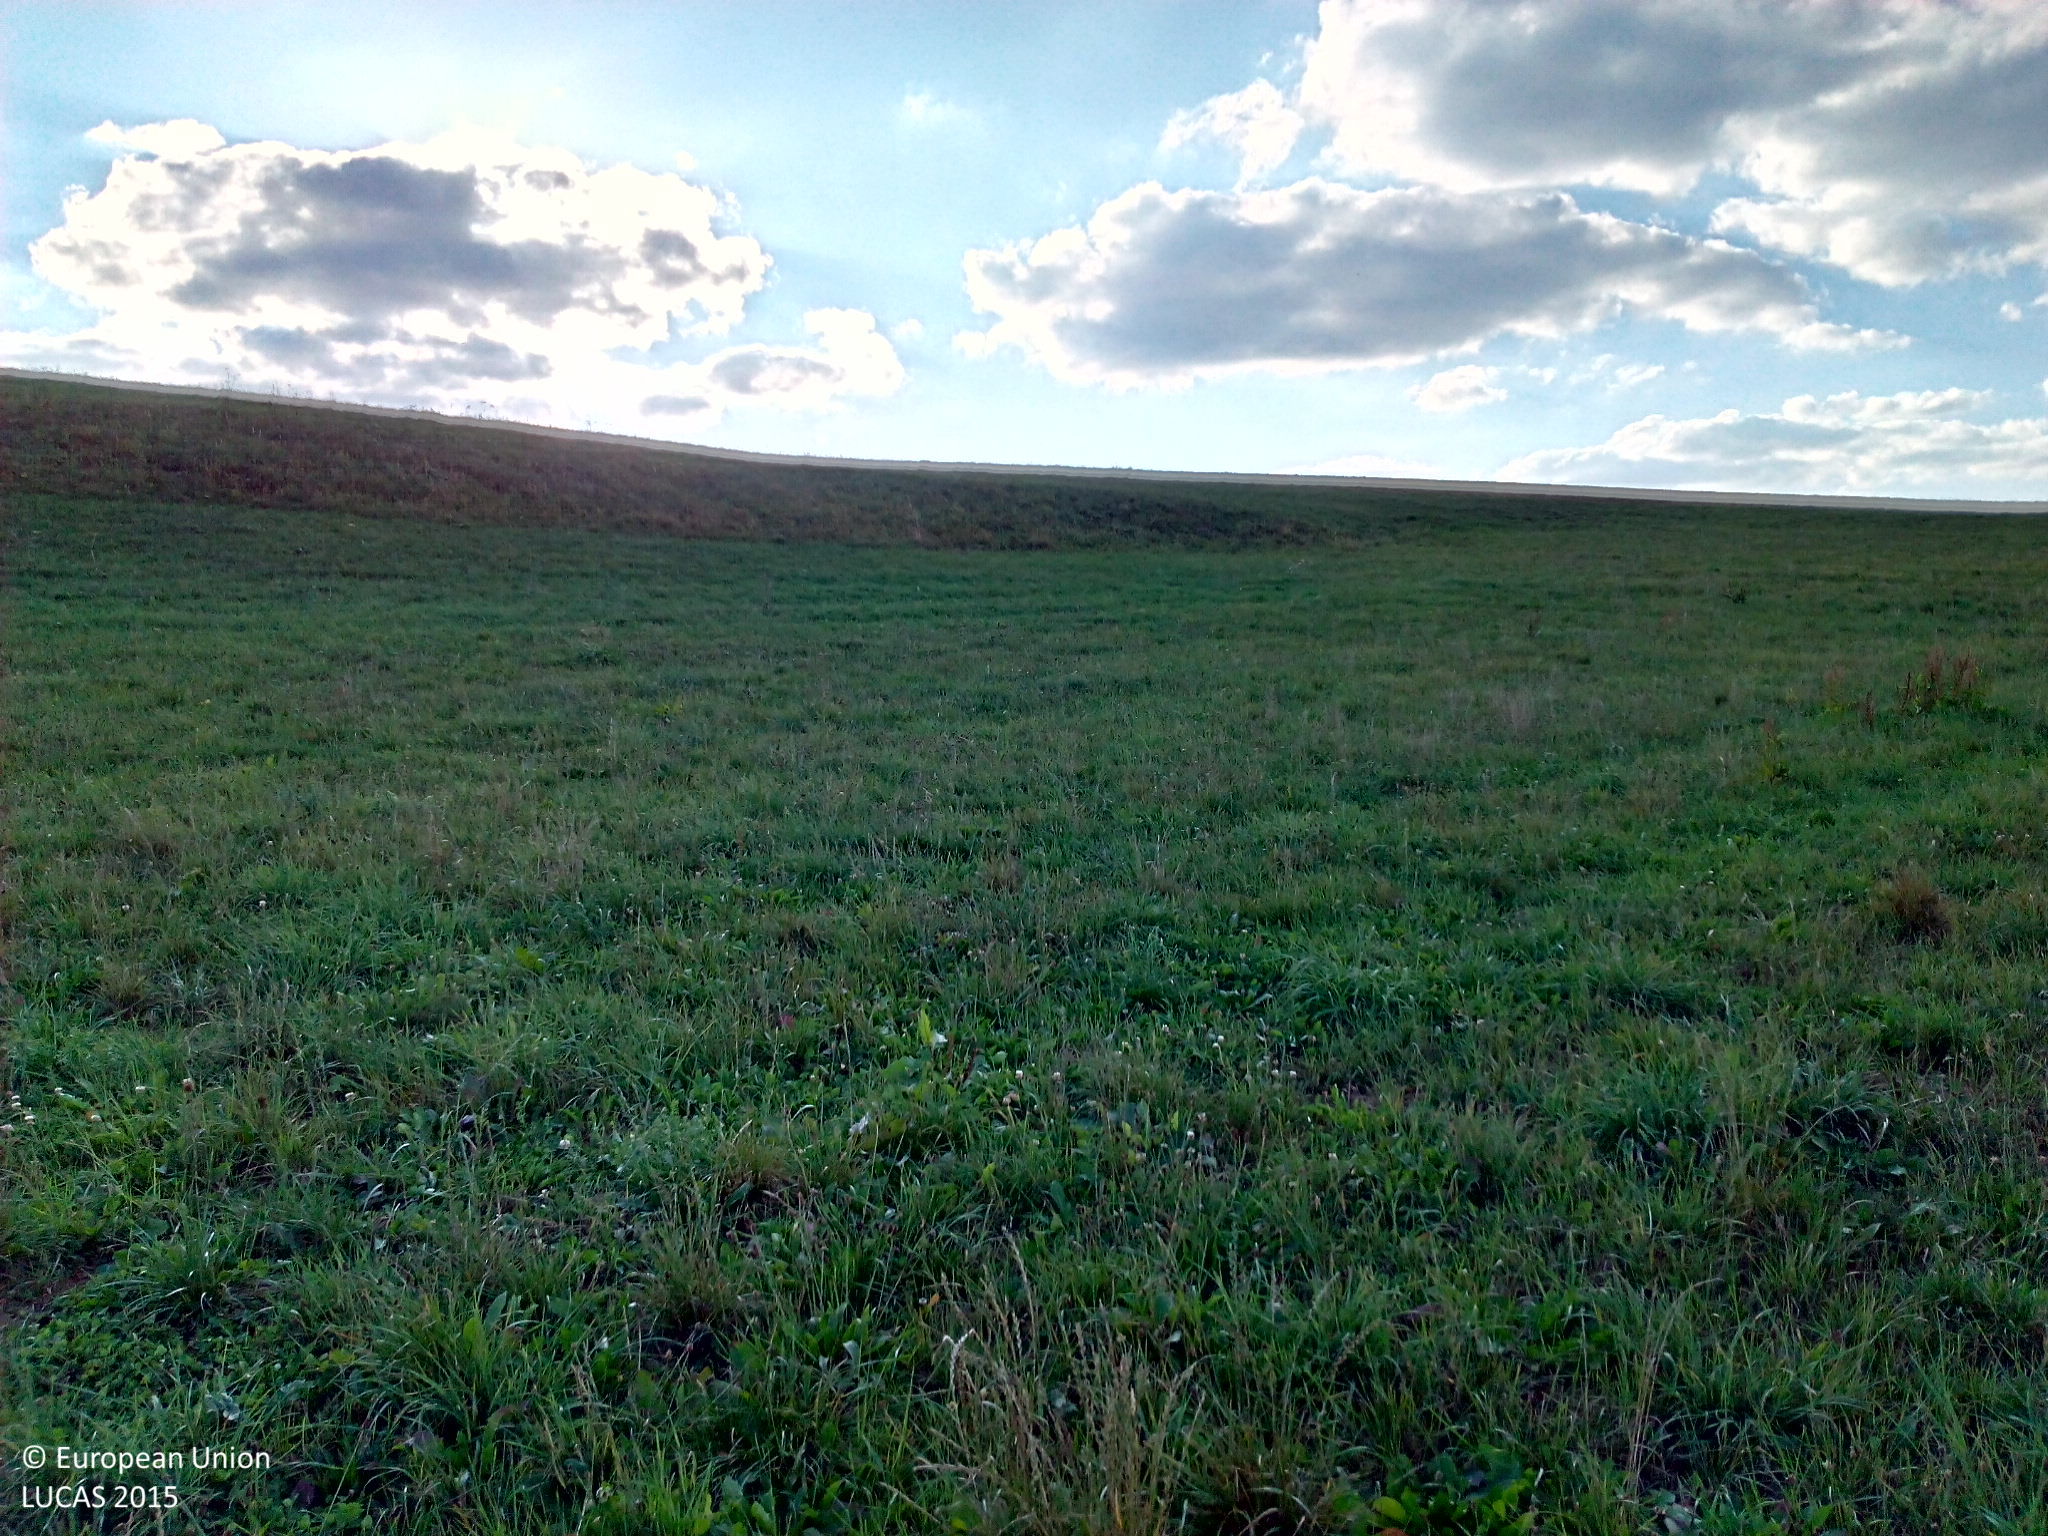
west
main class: Grassland
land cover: Grassland without tree/shrub cover
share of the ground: > 75 %
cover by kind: herbaceous plants 90 %, unconsolidated bare surface 10 %
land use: Agriculture (excluding fallow land and kitchen gardens)
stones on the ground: < 10 %
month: September
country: DE
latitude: 48.1242
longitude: 8.5633
